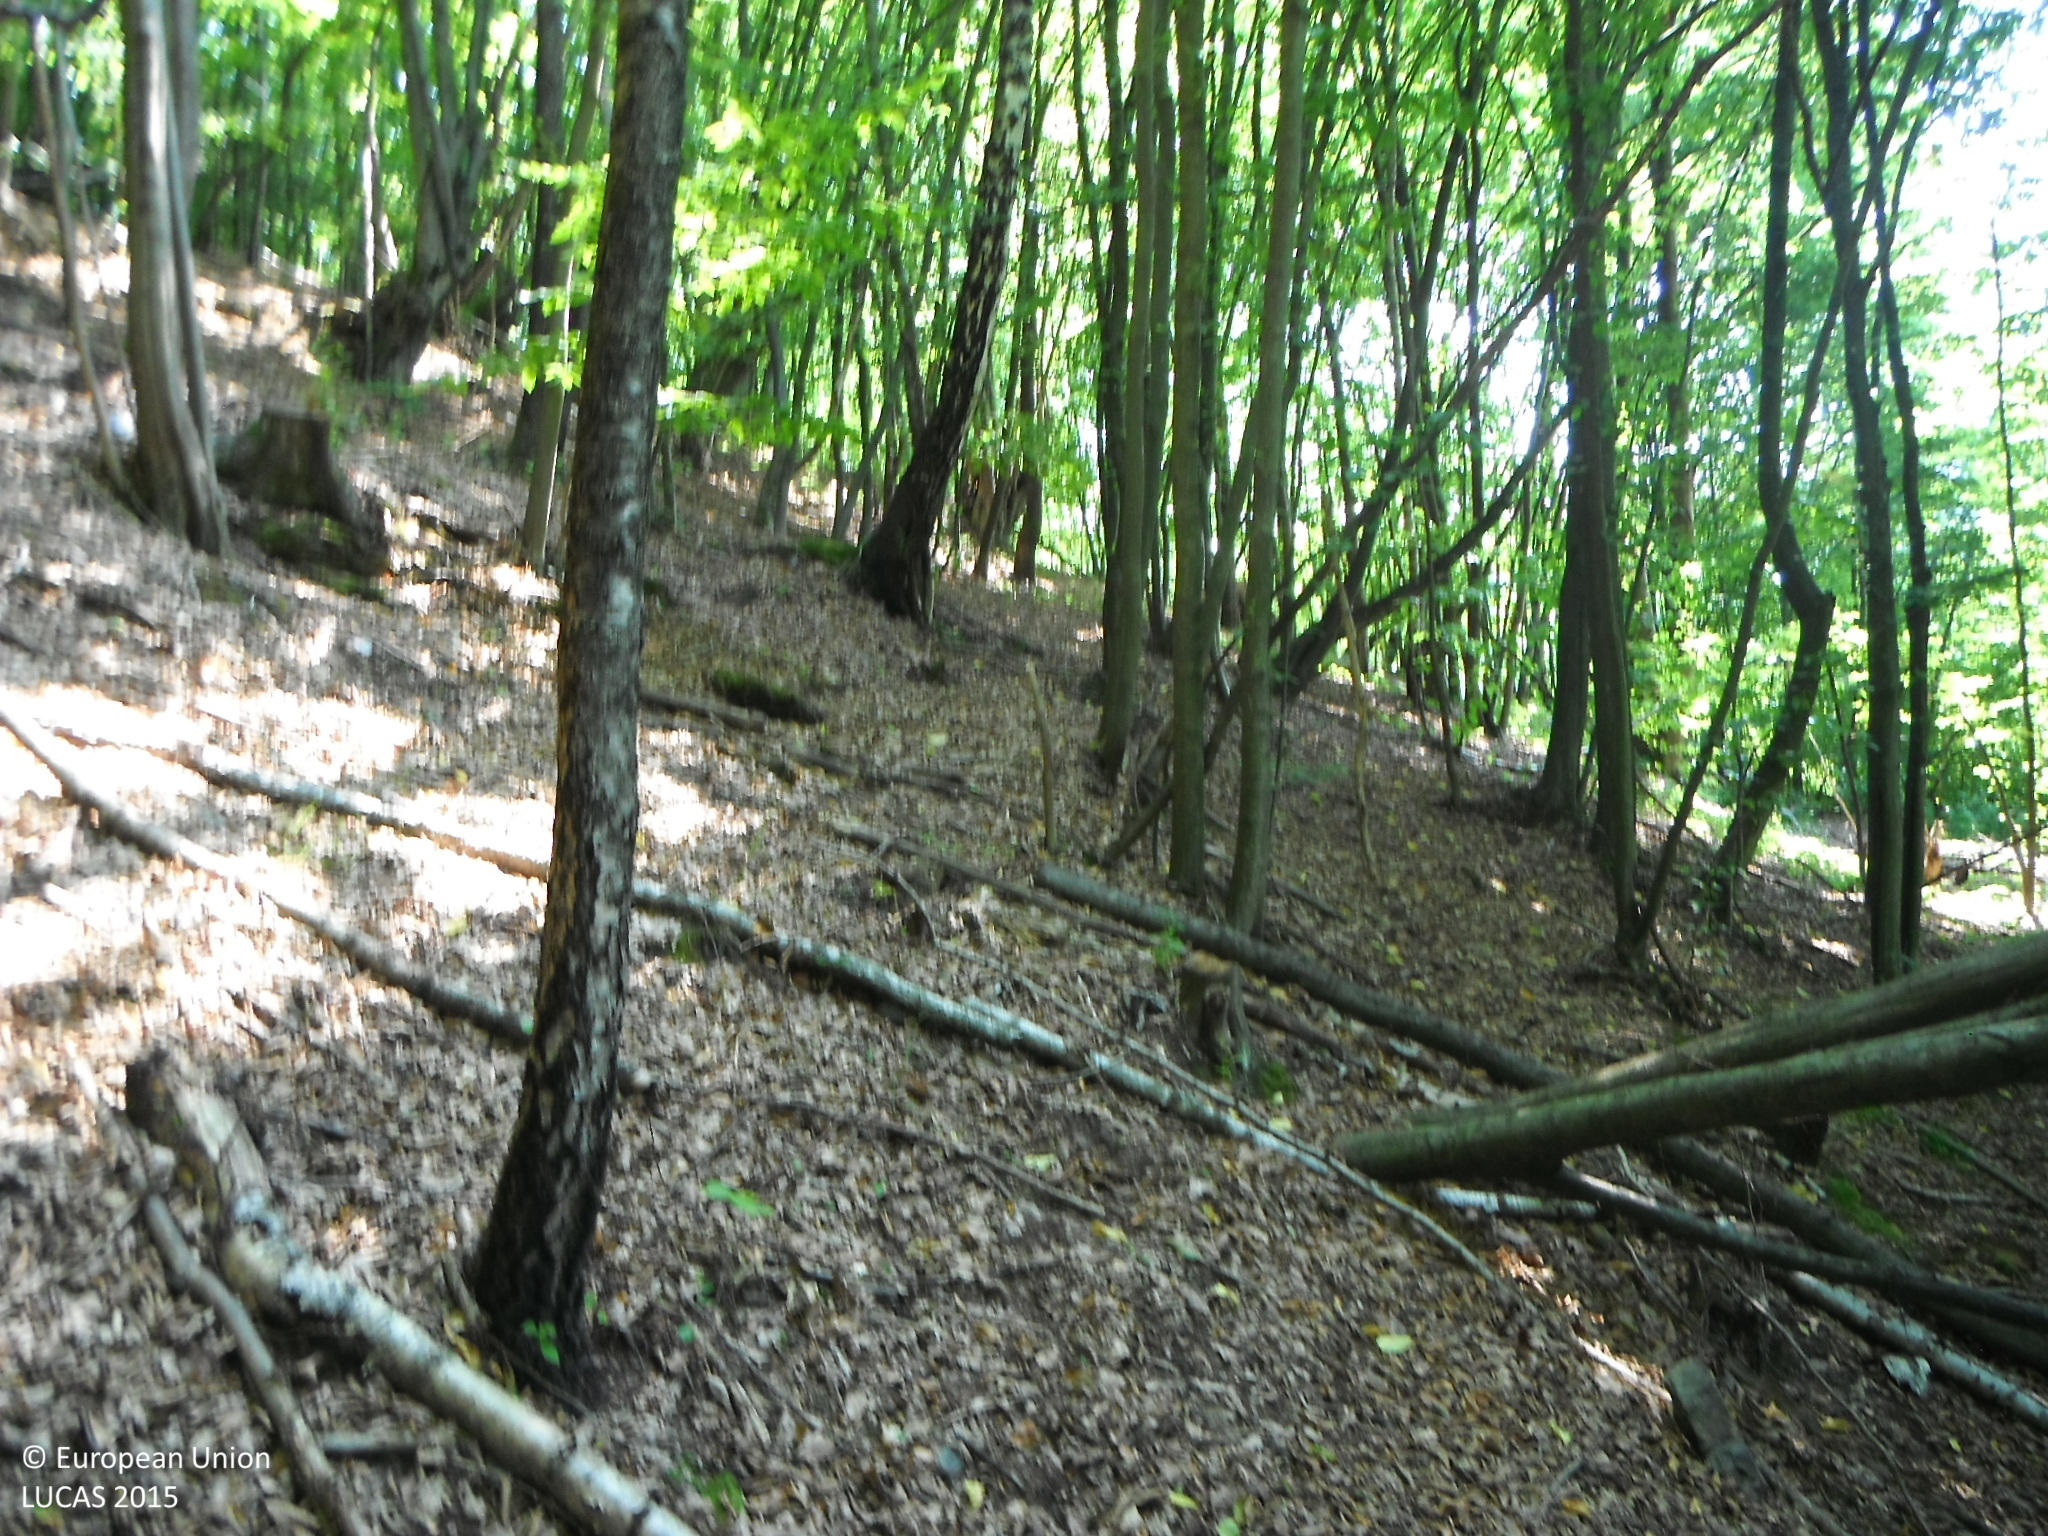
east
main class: Woodland
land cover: Broadleaved woodland
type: beech forest
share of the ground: > 75 %
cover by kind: broadleaved forest trees 100 %
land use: Forestry
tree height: > 5 m
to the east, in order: Broadleaved woodland
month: August
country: SK
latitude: 48.7552
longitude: 20.3030
